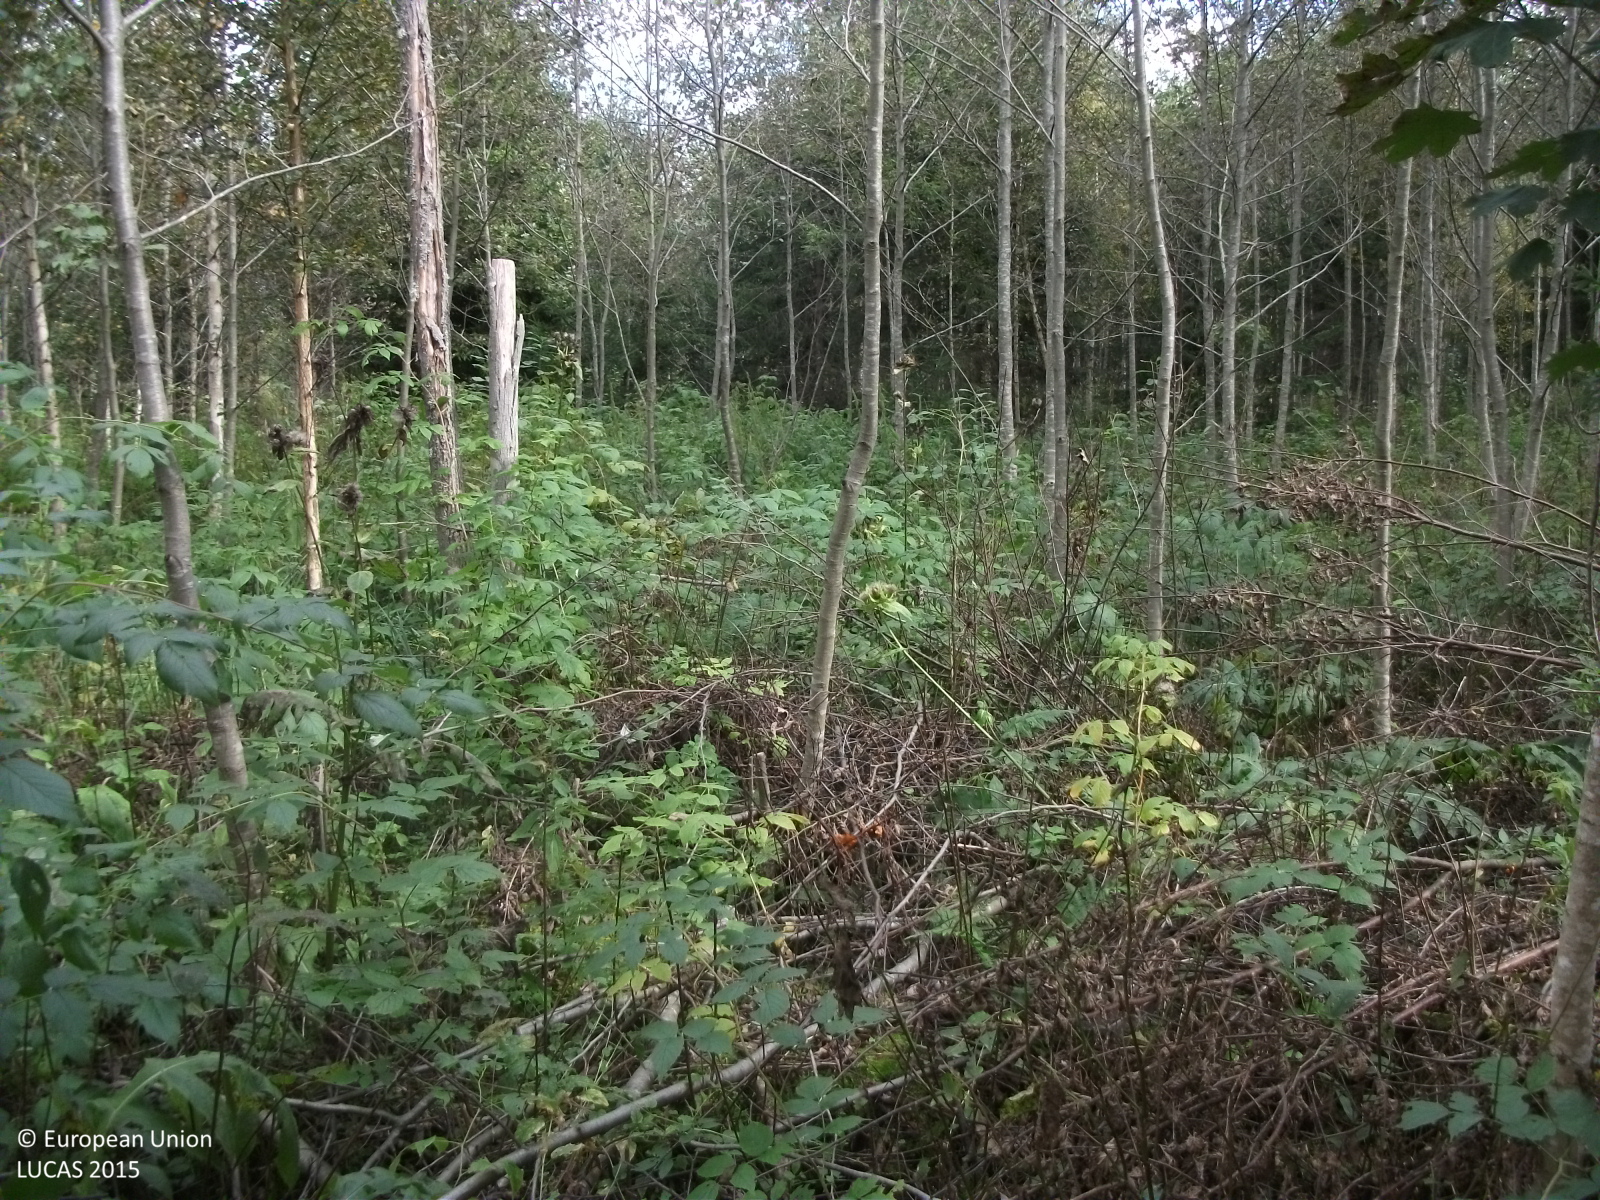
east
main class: Woodland
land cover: Broadleaved woodland
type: non-riverine alder, birch or aspen forest
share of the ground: 50 - 75 %
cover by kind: broadleaved forest trees 70 %, herbaceous plants 15 %, shrubs 10 %, coniferous forest trees 5 %
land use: Forestry
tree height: > 5 m
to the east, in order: Broadleaved woodland
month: September
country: LV
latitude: 57.9352
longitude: 24.8748
